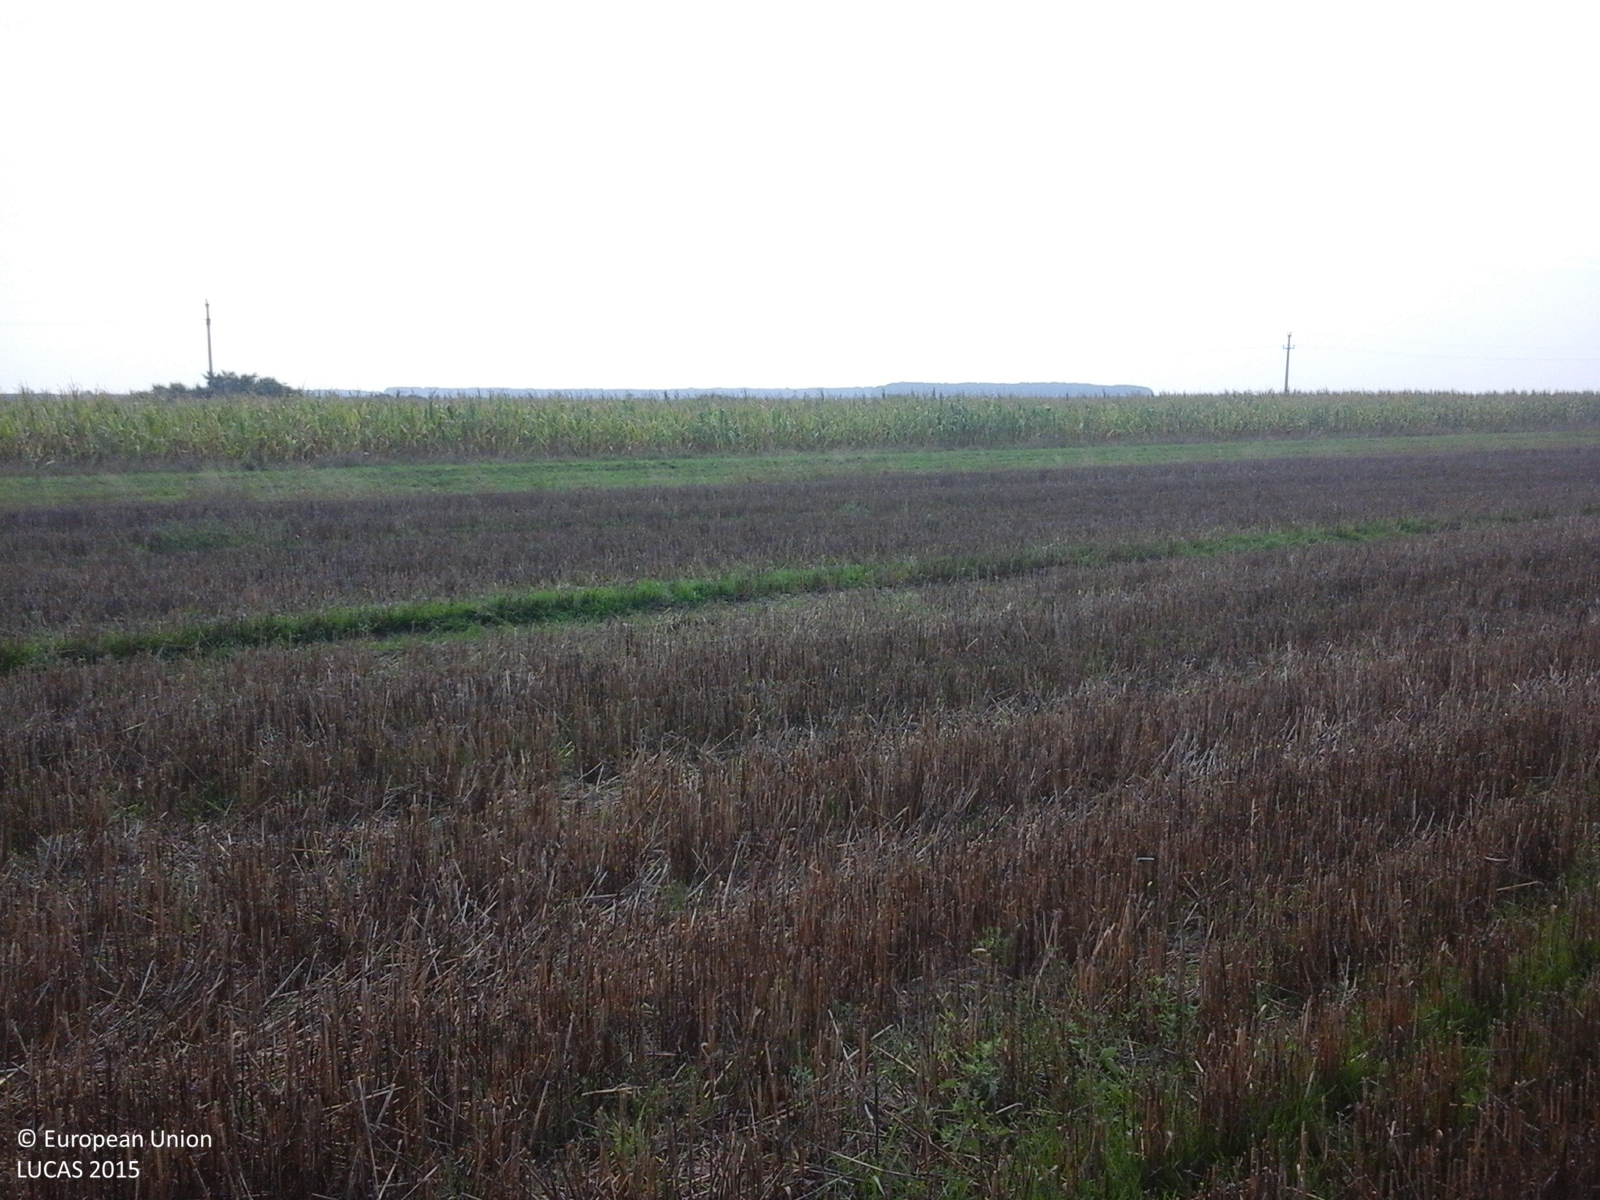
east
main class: Cropland
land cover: Durum wheat
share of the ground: > 75 %
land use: Agriculture (excluding fallow land and kitchen gardens)
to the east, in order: Durum wheat; Grassland without tree/shrub cover; Maize; Common wheat; Shruby margins; Ditches and canals; Spontaneously vegetated surfaces; Electric lines; Spontaneously vegetated surfaces; Maize; Common wheat; Lucerne
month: August
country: RO
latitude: 46.5357
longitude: 21.6047
